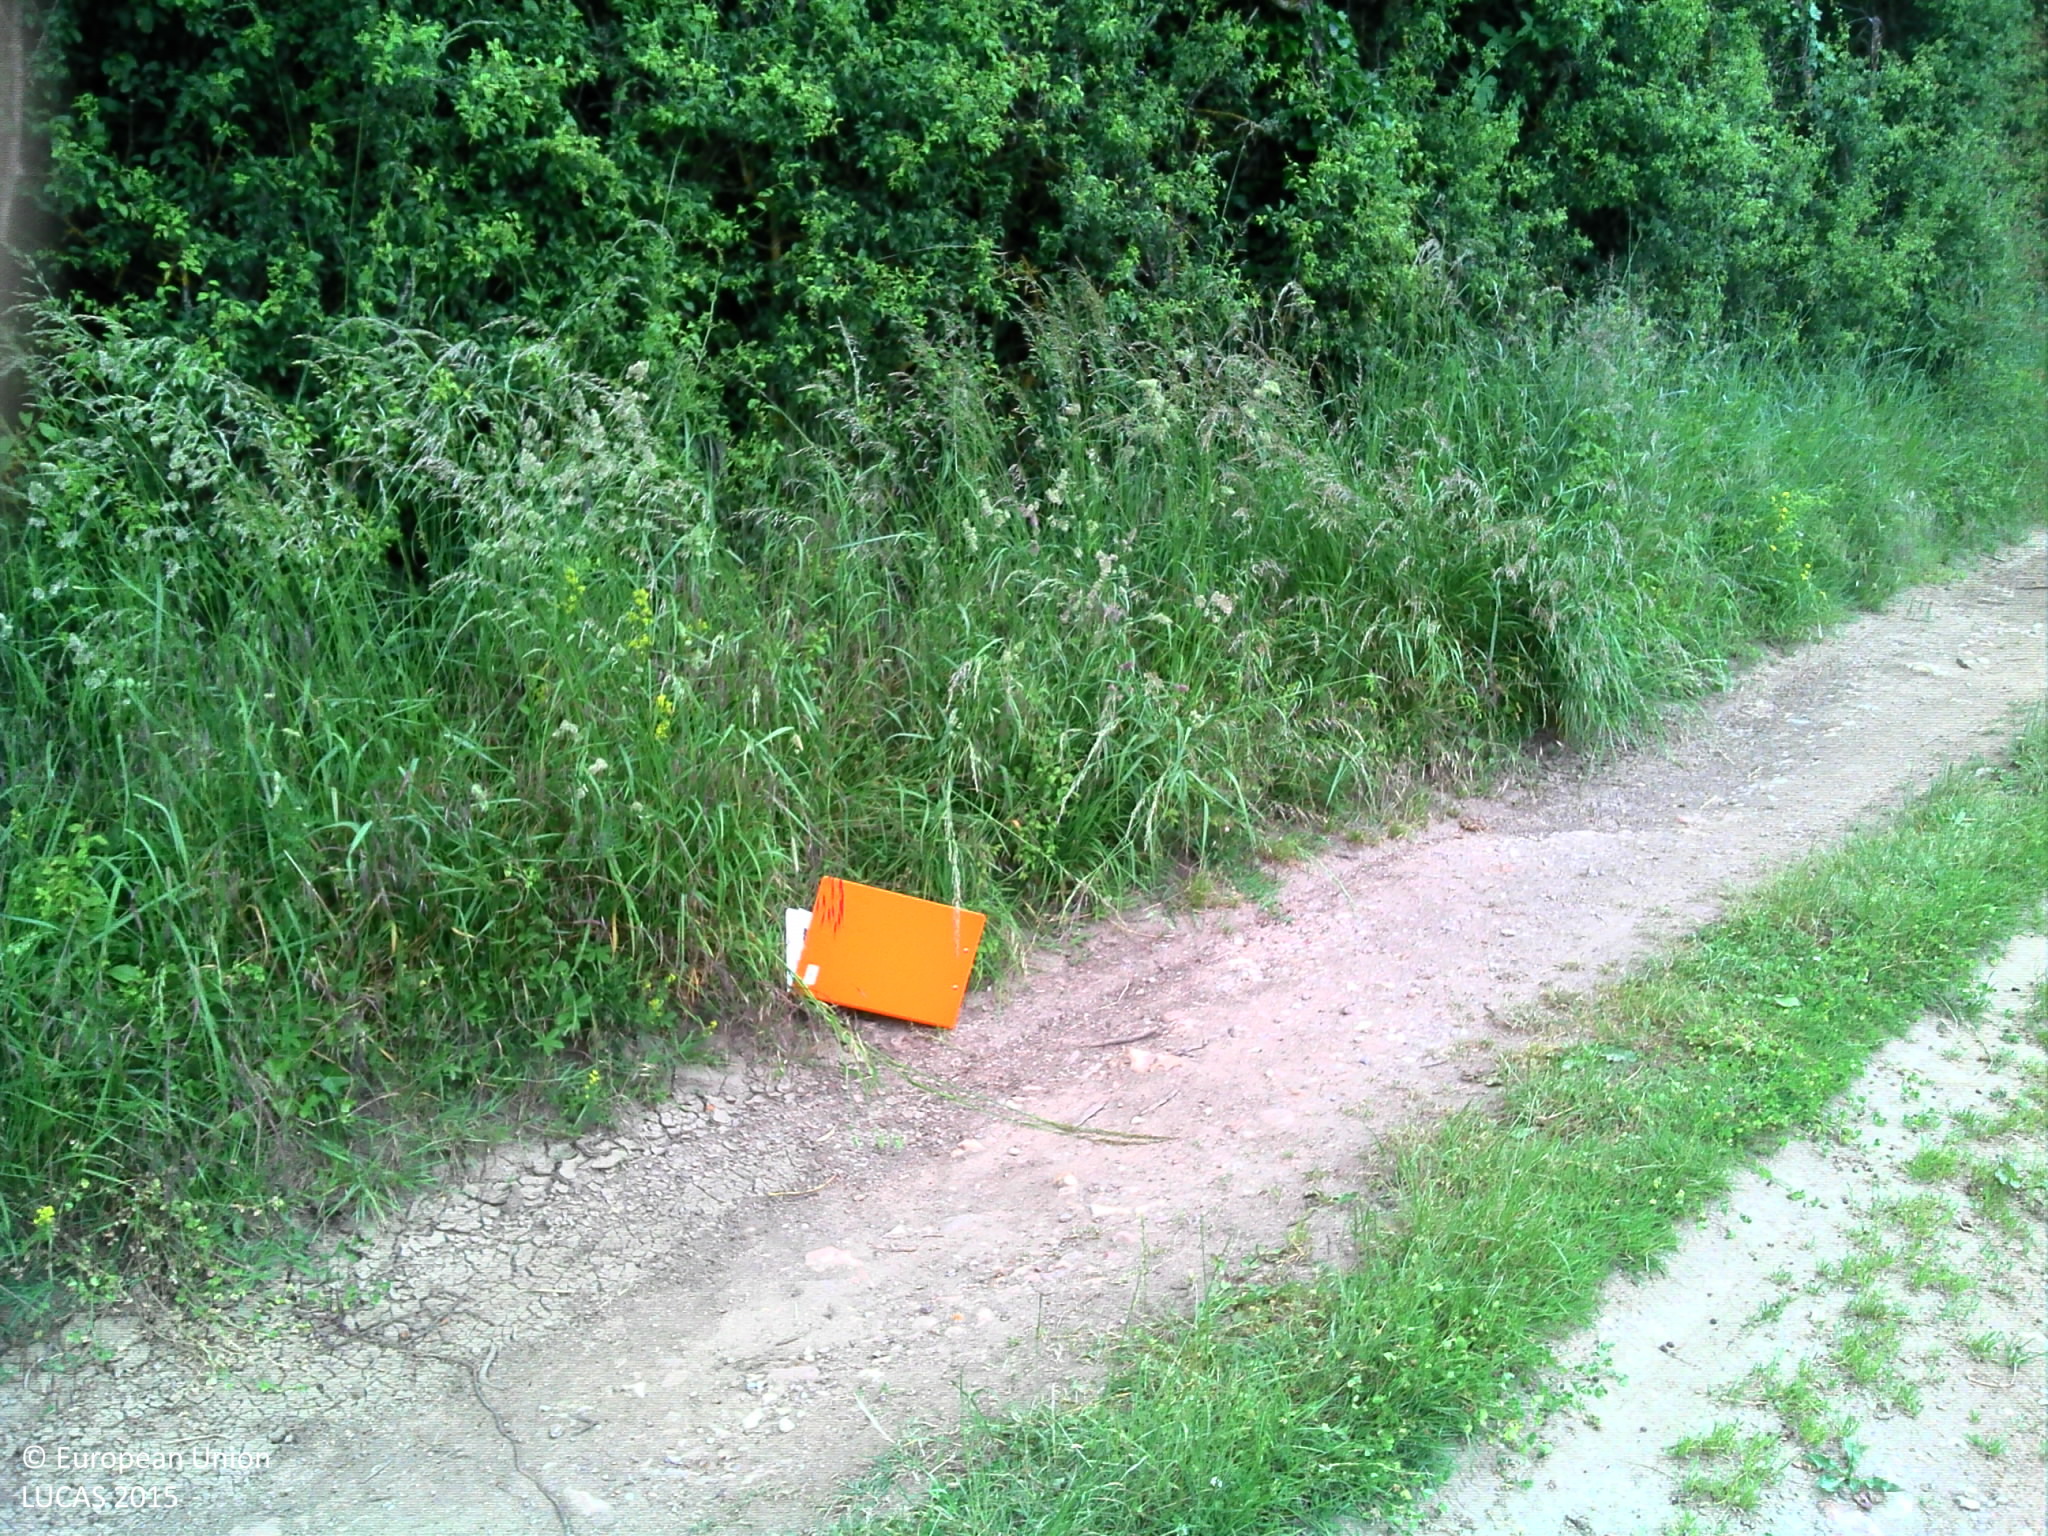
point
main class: Woodland
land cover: Broadleaved woodland
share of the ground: > 75 %
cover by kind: broadleaved forest trees 100 %
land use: Semi-natural and natural areas not in use
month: May
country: FR
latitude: 47.3415
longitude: 2.8601
